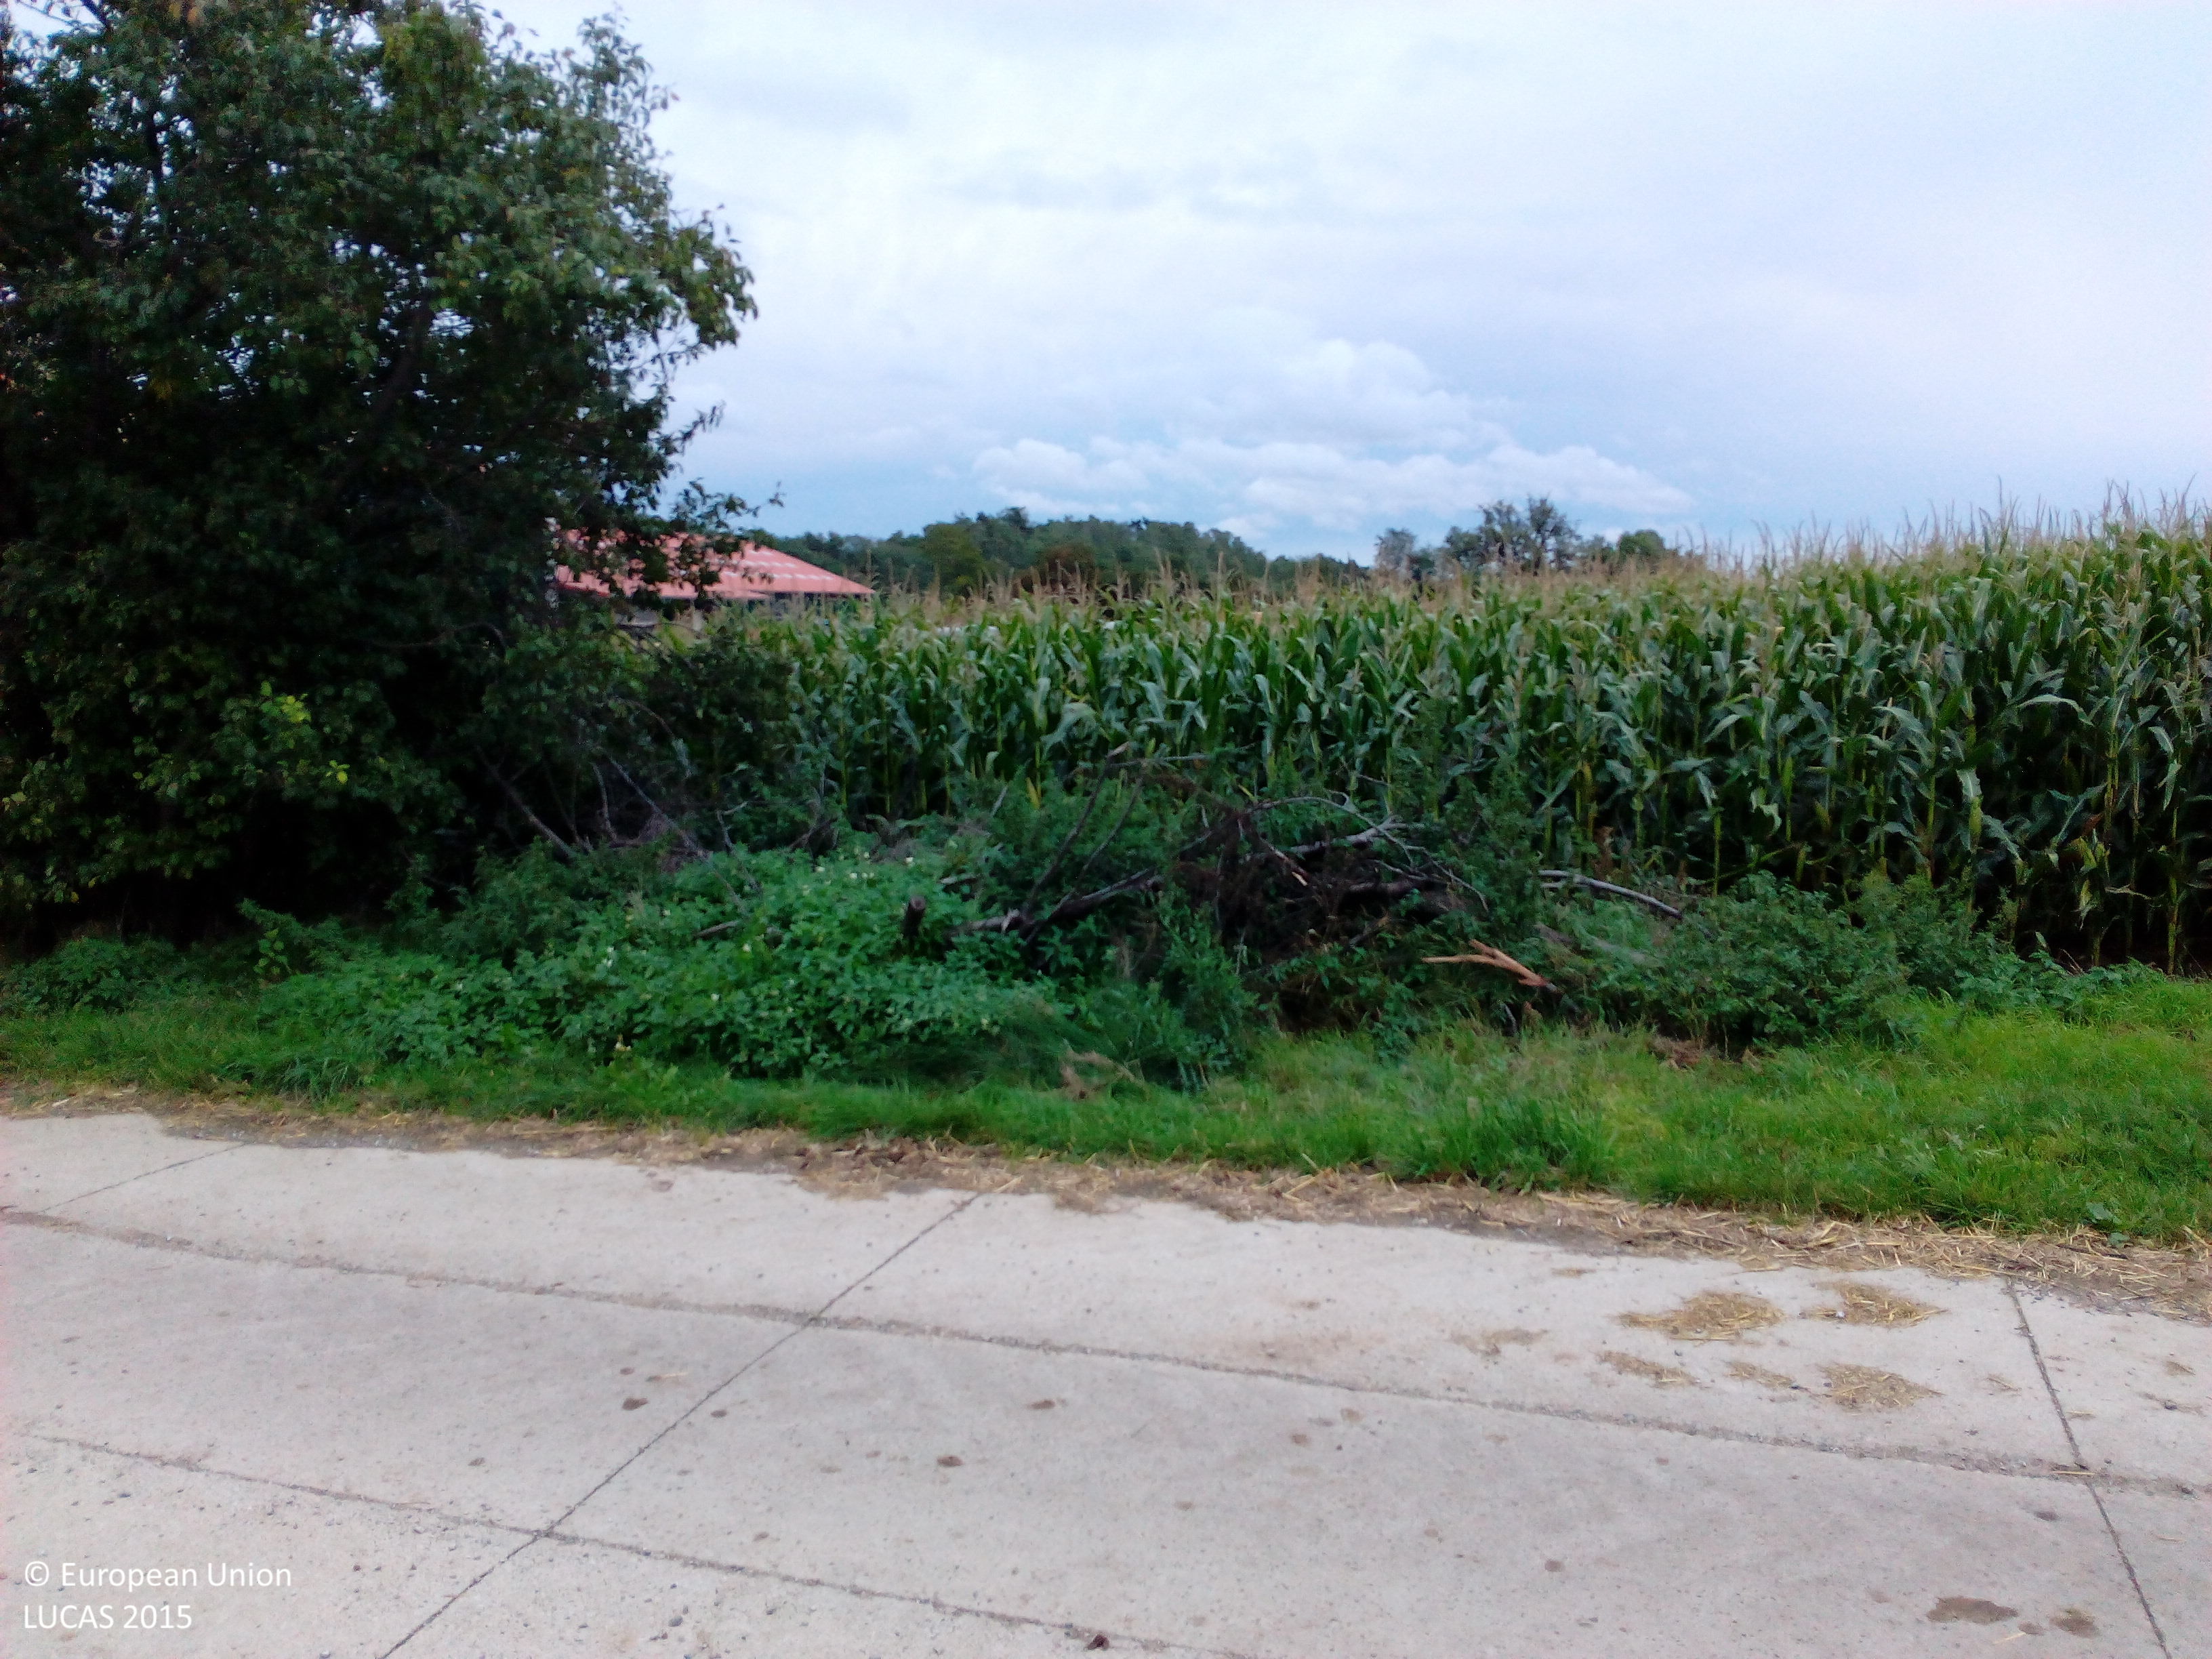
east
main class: Shrubland
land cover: Shrubland without tree cover
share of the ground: > 75 %
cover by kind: shrubs 90 %, herbaceous plants 10 %
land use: Semi-natural and natural areas not in use
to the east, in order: Shrubland without tree cover; Fences; Grass margins; Paved roads, cycling and walking lanes; Grass margins; Maize; Artificial constructions in urban areas; Lines of trees; Maize
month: September
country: DE
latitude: 51.8158
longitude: 11.0296
